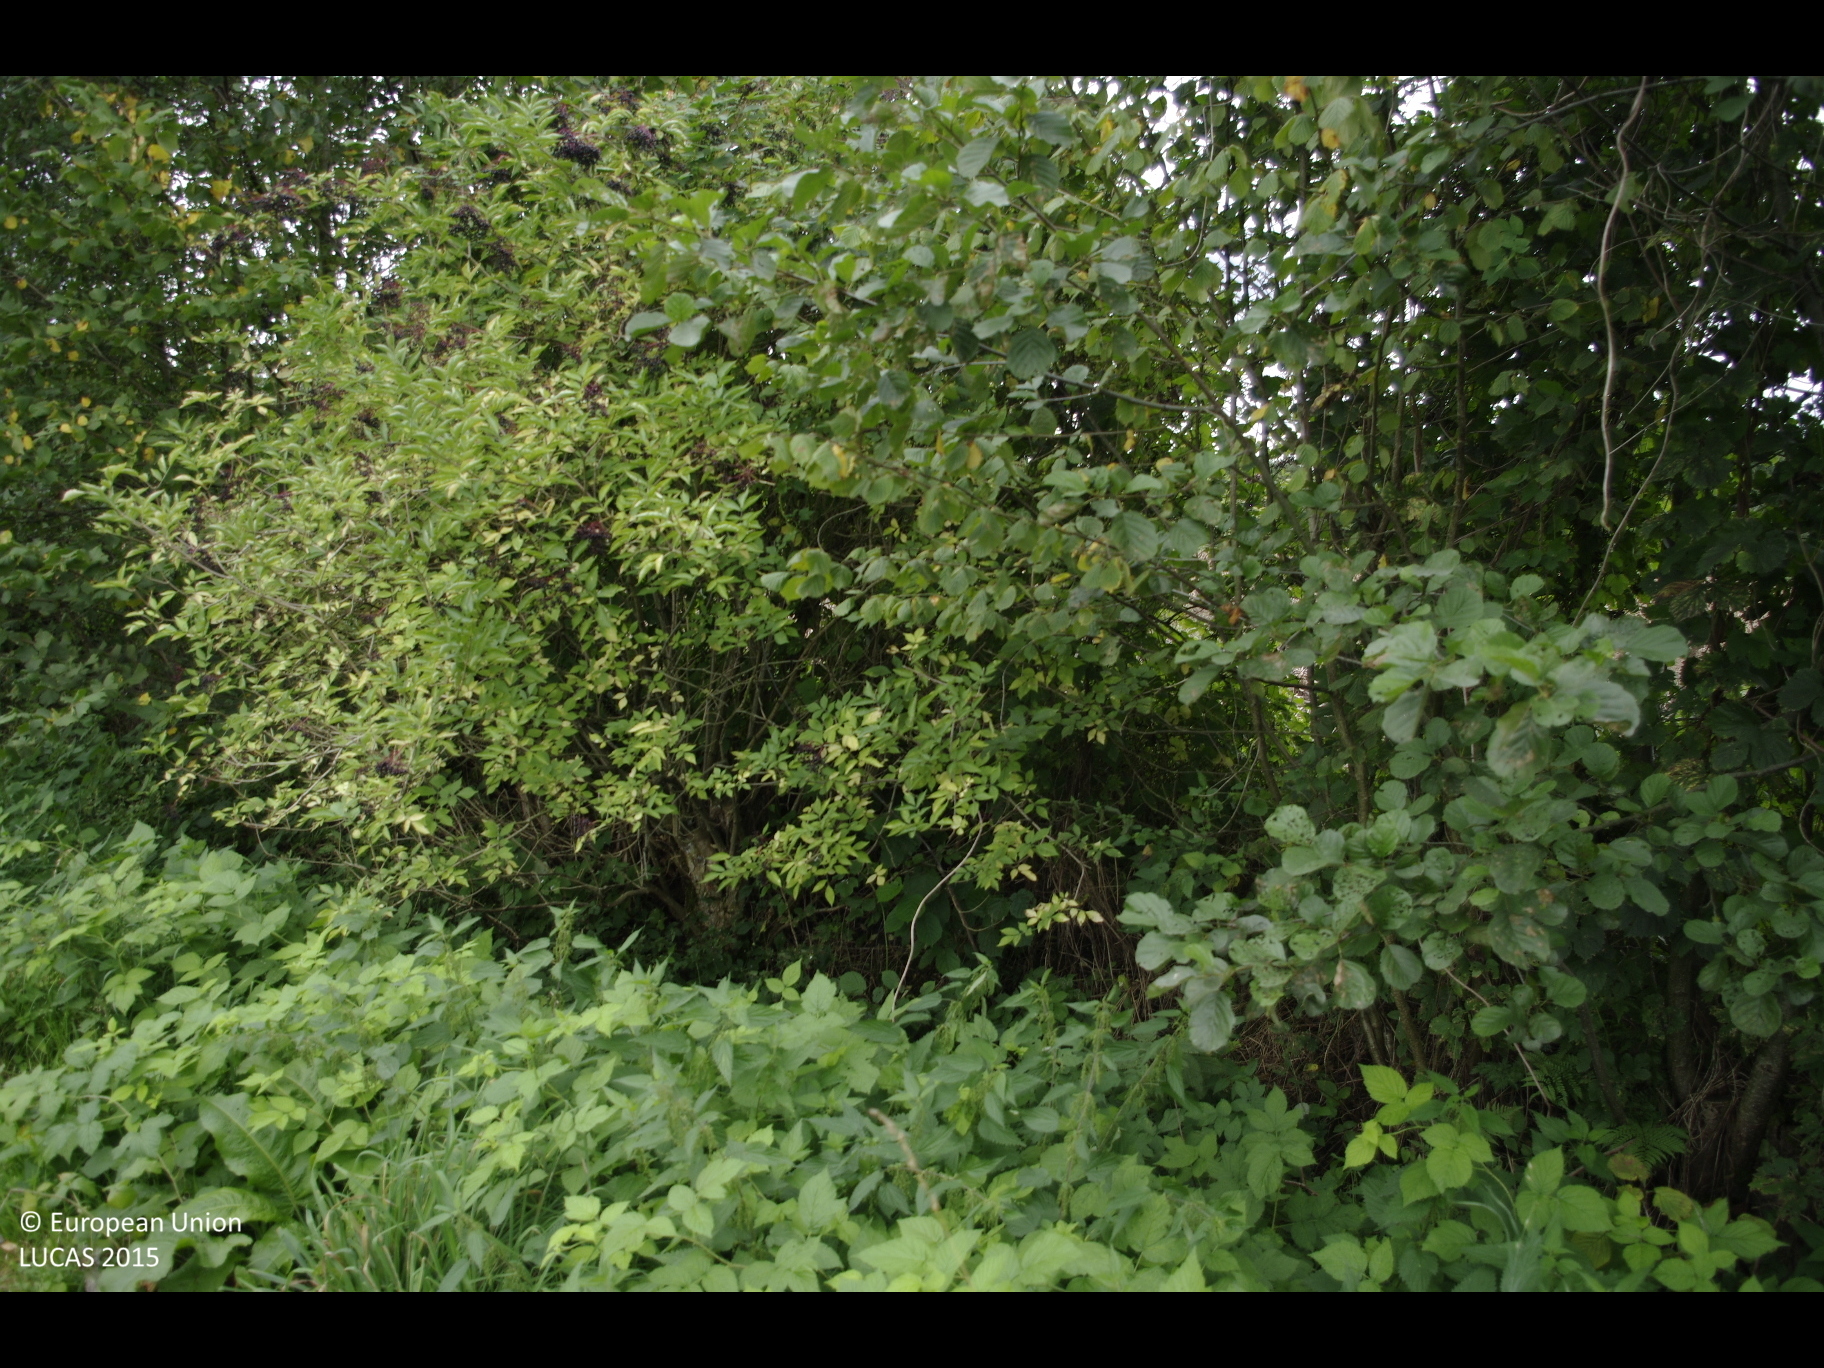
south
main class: Cropland
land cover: Potatoes
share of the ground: 50 - 75 %
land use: Agriculture (excluding fallow land and kitchen gardens)
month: September
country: DE
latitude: 53.5992
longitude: 10.3172
